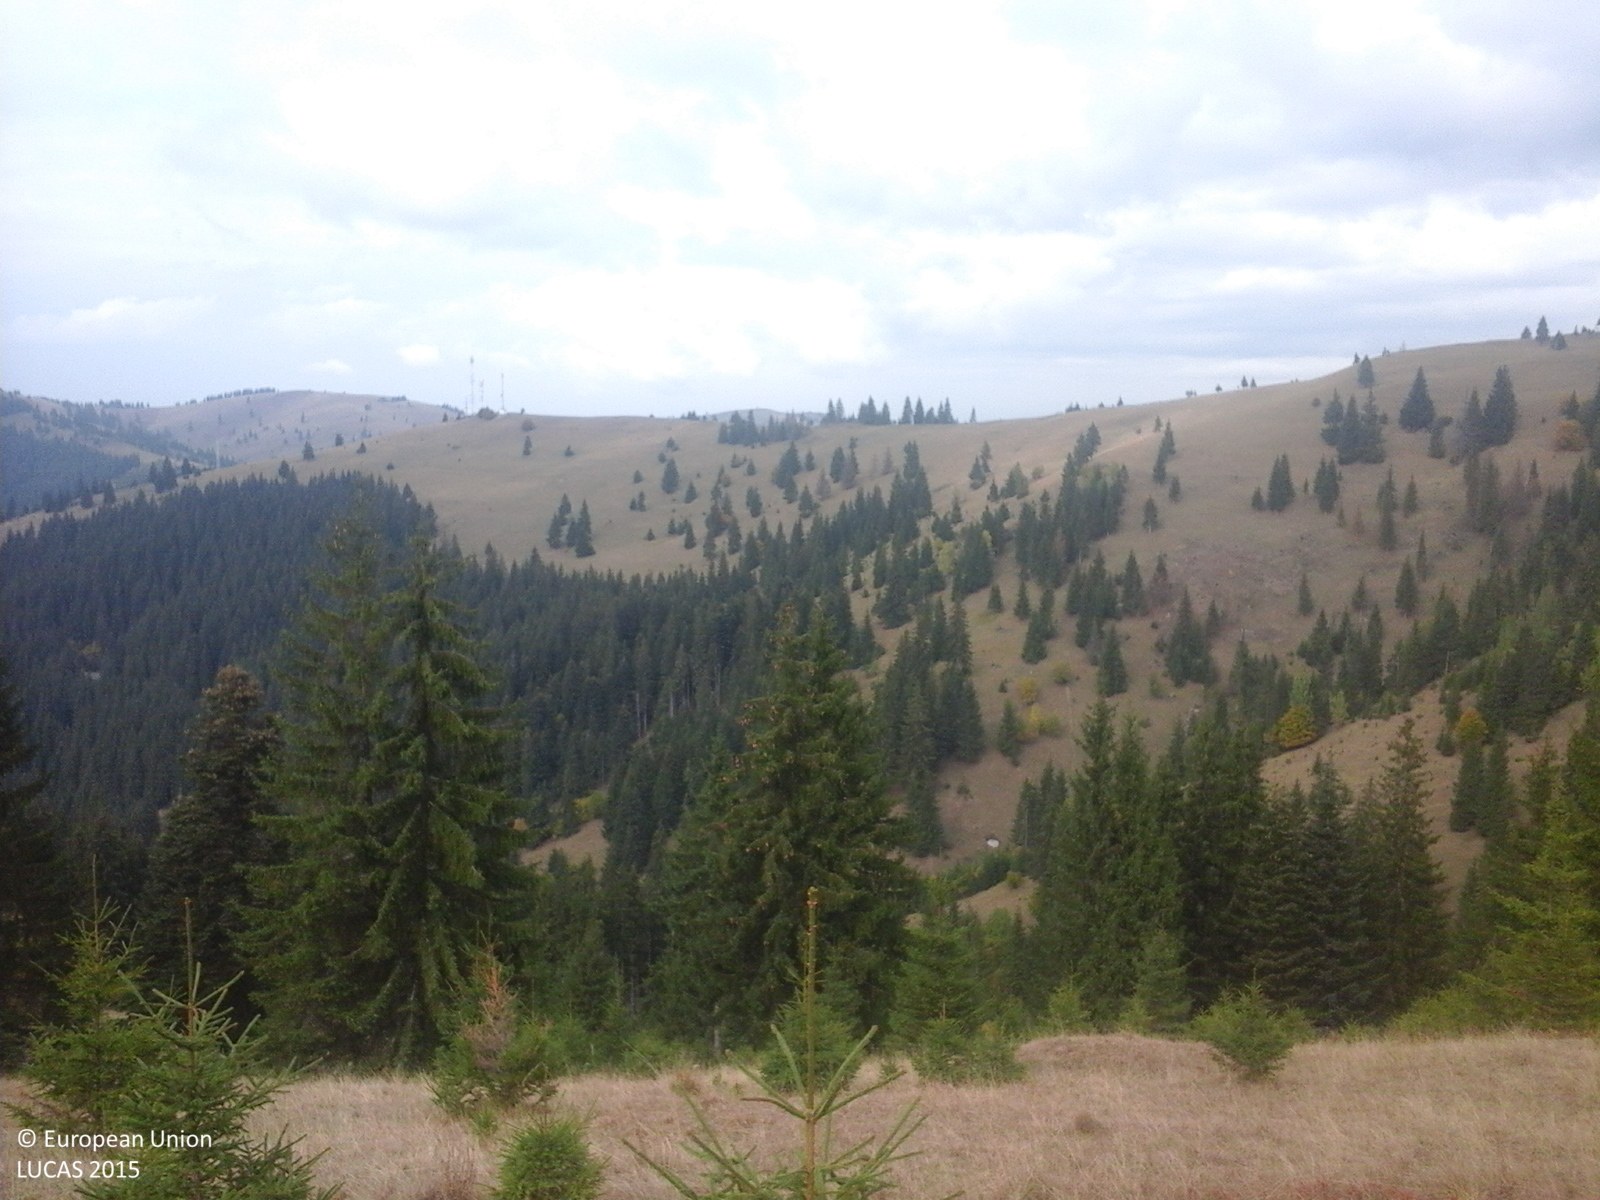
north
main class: Grassland
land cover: Grassland with sparse tree/shrub cover
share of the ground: > 75 %
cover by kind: herbaceous plants 85 %, shrubs 10 %, broadleaved forest trees 5 %
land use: Agriculture (excluding fallow land and kitchen gardens)
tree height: < 5 m
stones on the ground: < 10 %
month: October
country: RO
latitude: 46.4492
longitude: 25.9361
